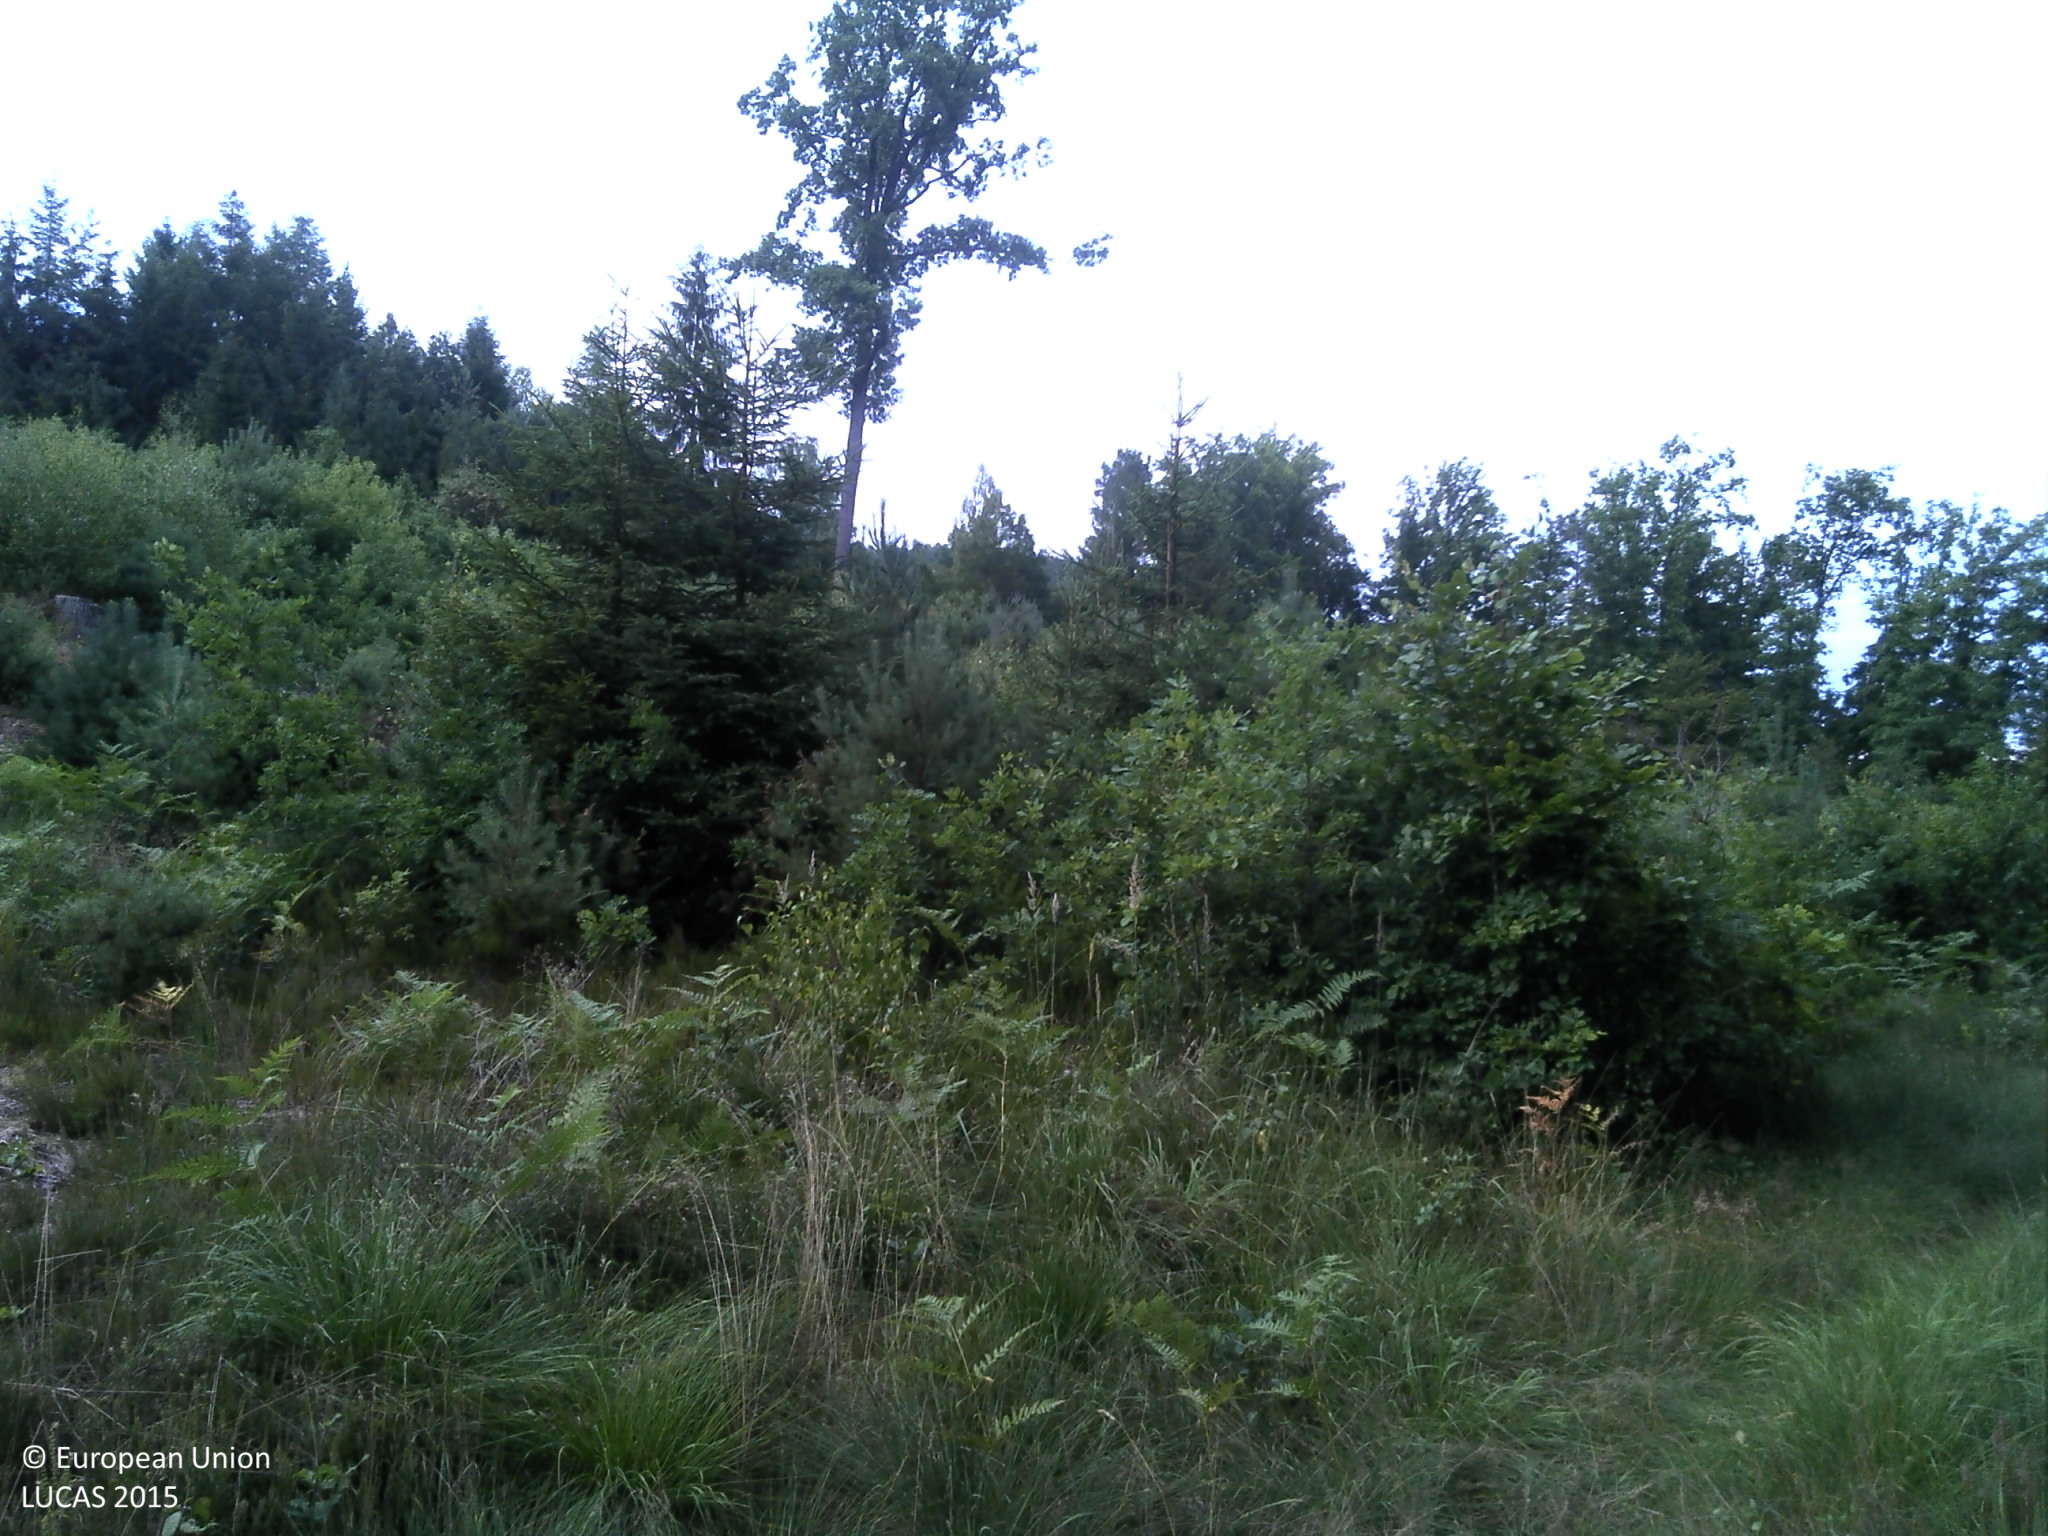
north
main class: Woodland
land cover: Spruce dominated coniferous woodland
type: hemiboreal forest and nemoral coniferous forest and mixed broadleaved-coniferous forest
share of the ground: > 75 %
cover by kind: coniferous forest trees 90 %, broadleaved forest trees 10 %
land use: Forestry
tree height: > 5 m
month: July
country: FR
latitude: 49.0052
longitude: 7.4989
